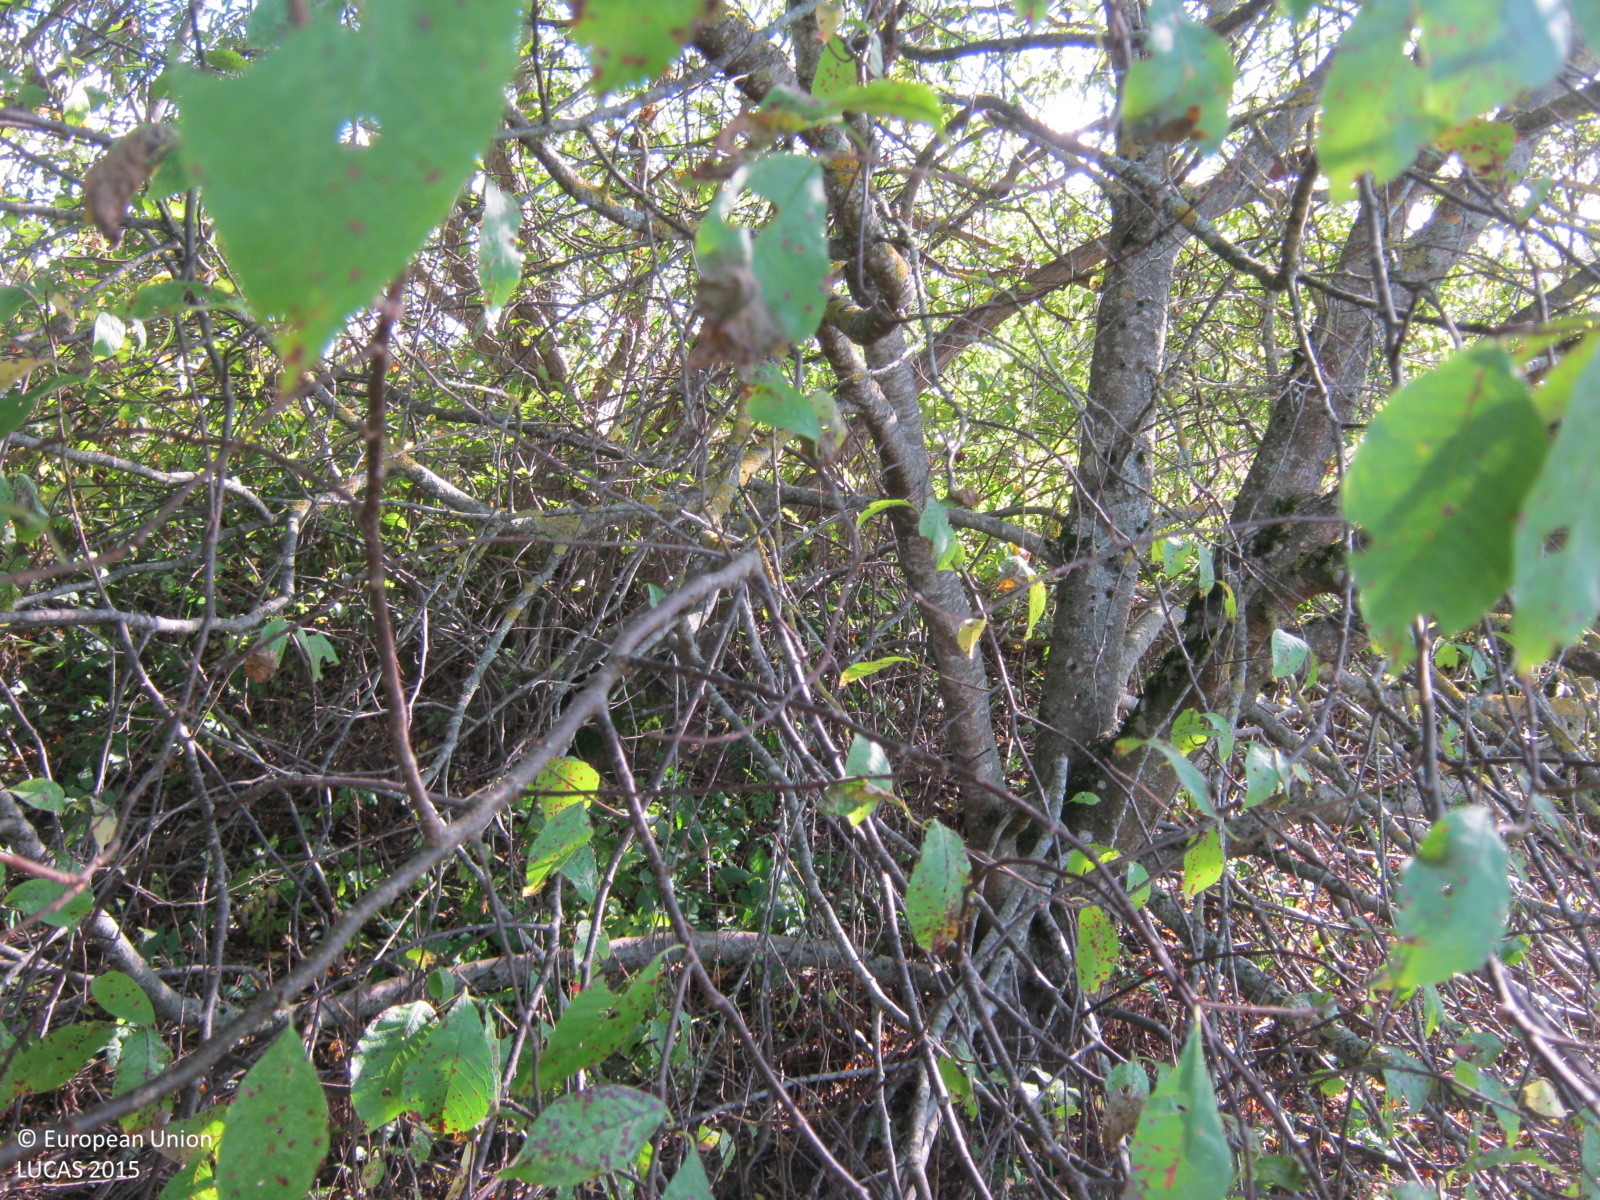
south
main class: Woodland
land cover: Broadleaved woodland
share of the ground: > 75 %
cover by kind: broadleaved forest trees 90 %, herbaceous plants 10 %
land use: Semi-natural and natural areas not in use
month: September
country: LV
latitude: 57.2828
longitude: 24.6438
